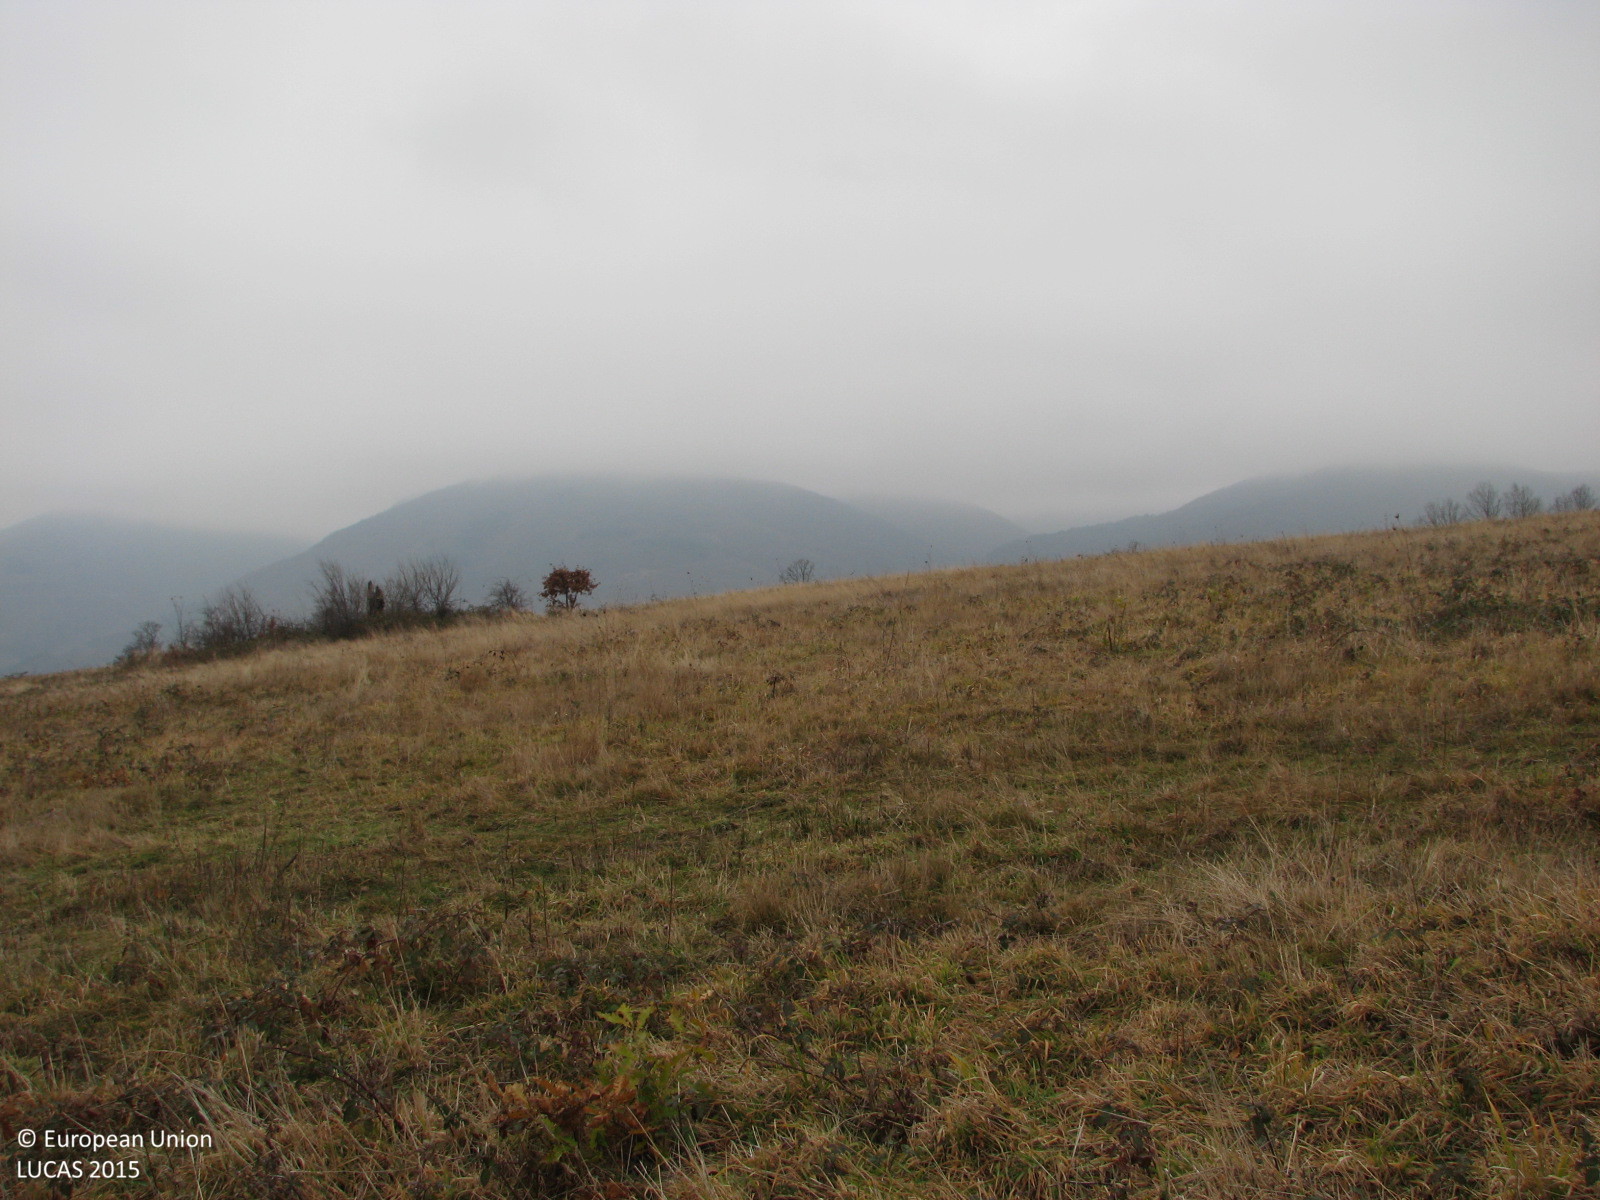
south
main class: Grassland
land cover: Grassland without tree/shrub cover
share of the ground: > 75 %
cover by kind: herbaceous plants 100 %
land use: Agriculture (excluding fallow land and kitchen gardens)
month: December
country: BG
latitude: 42.2374
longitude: 23.9135
